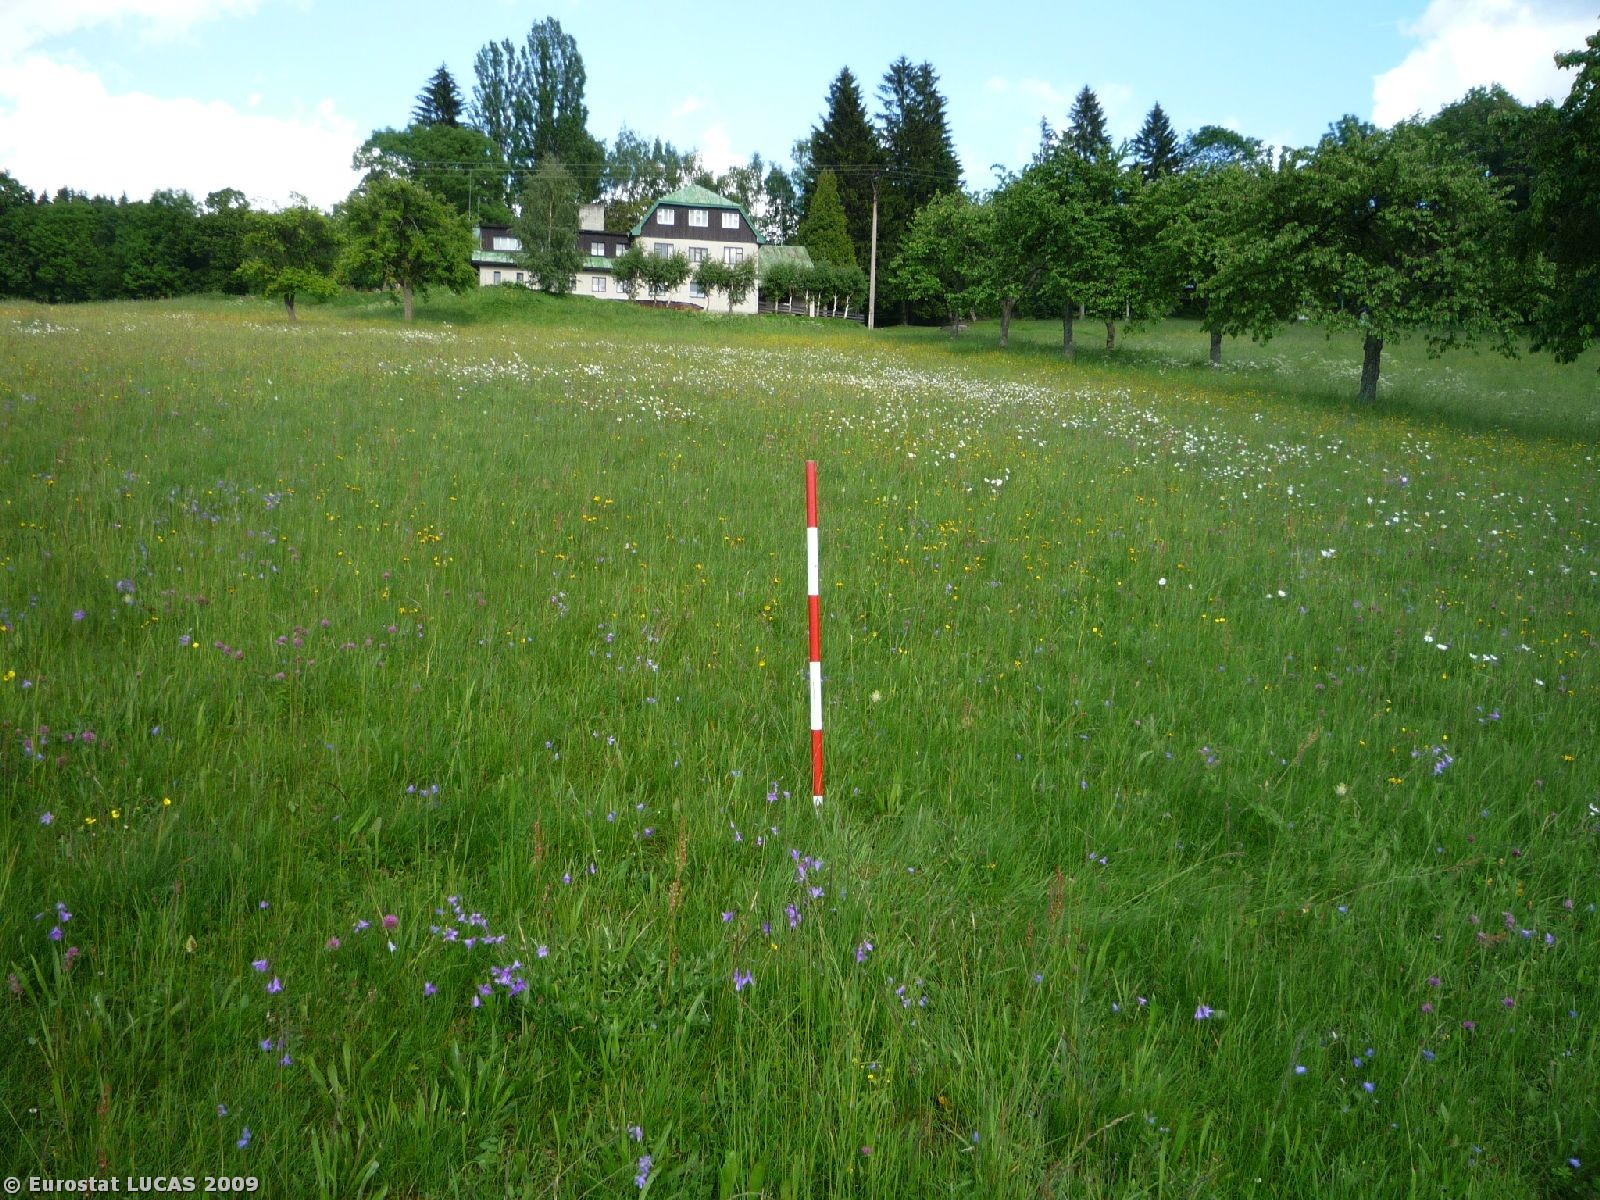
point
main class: Grassland
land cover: Grassland without tree/shrub cover
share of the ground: > 75 %
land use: Agriculture (excluding fallow land and kitchen gardens)
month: June
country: CZ
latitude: 50.6626
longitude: 15.5358
